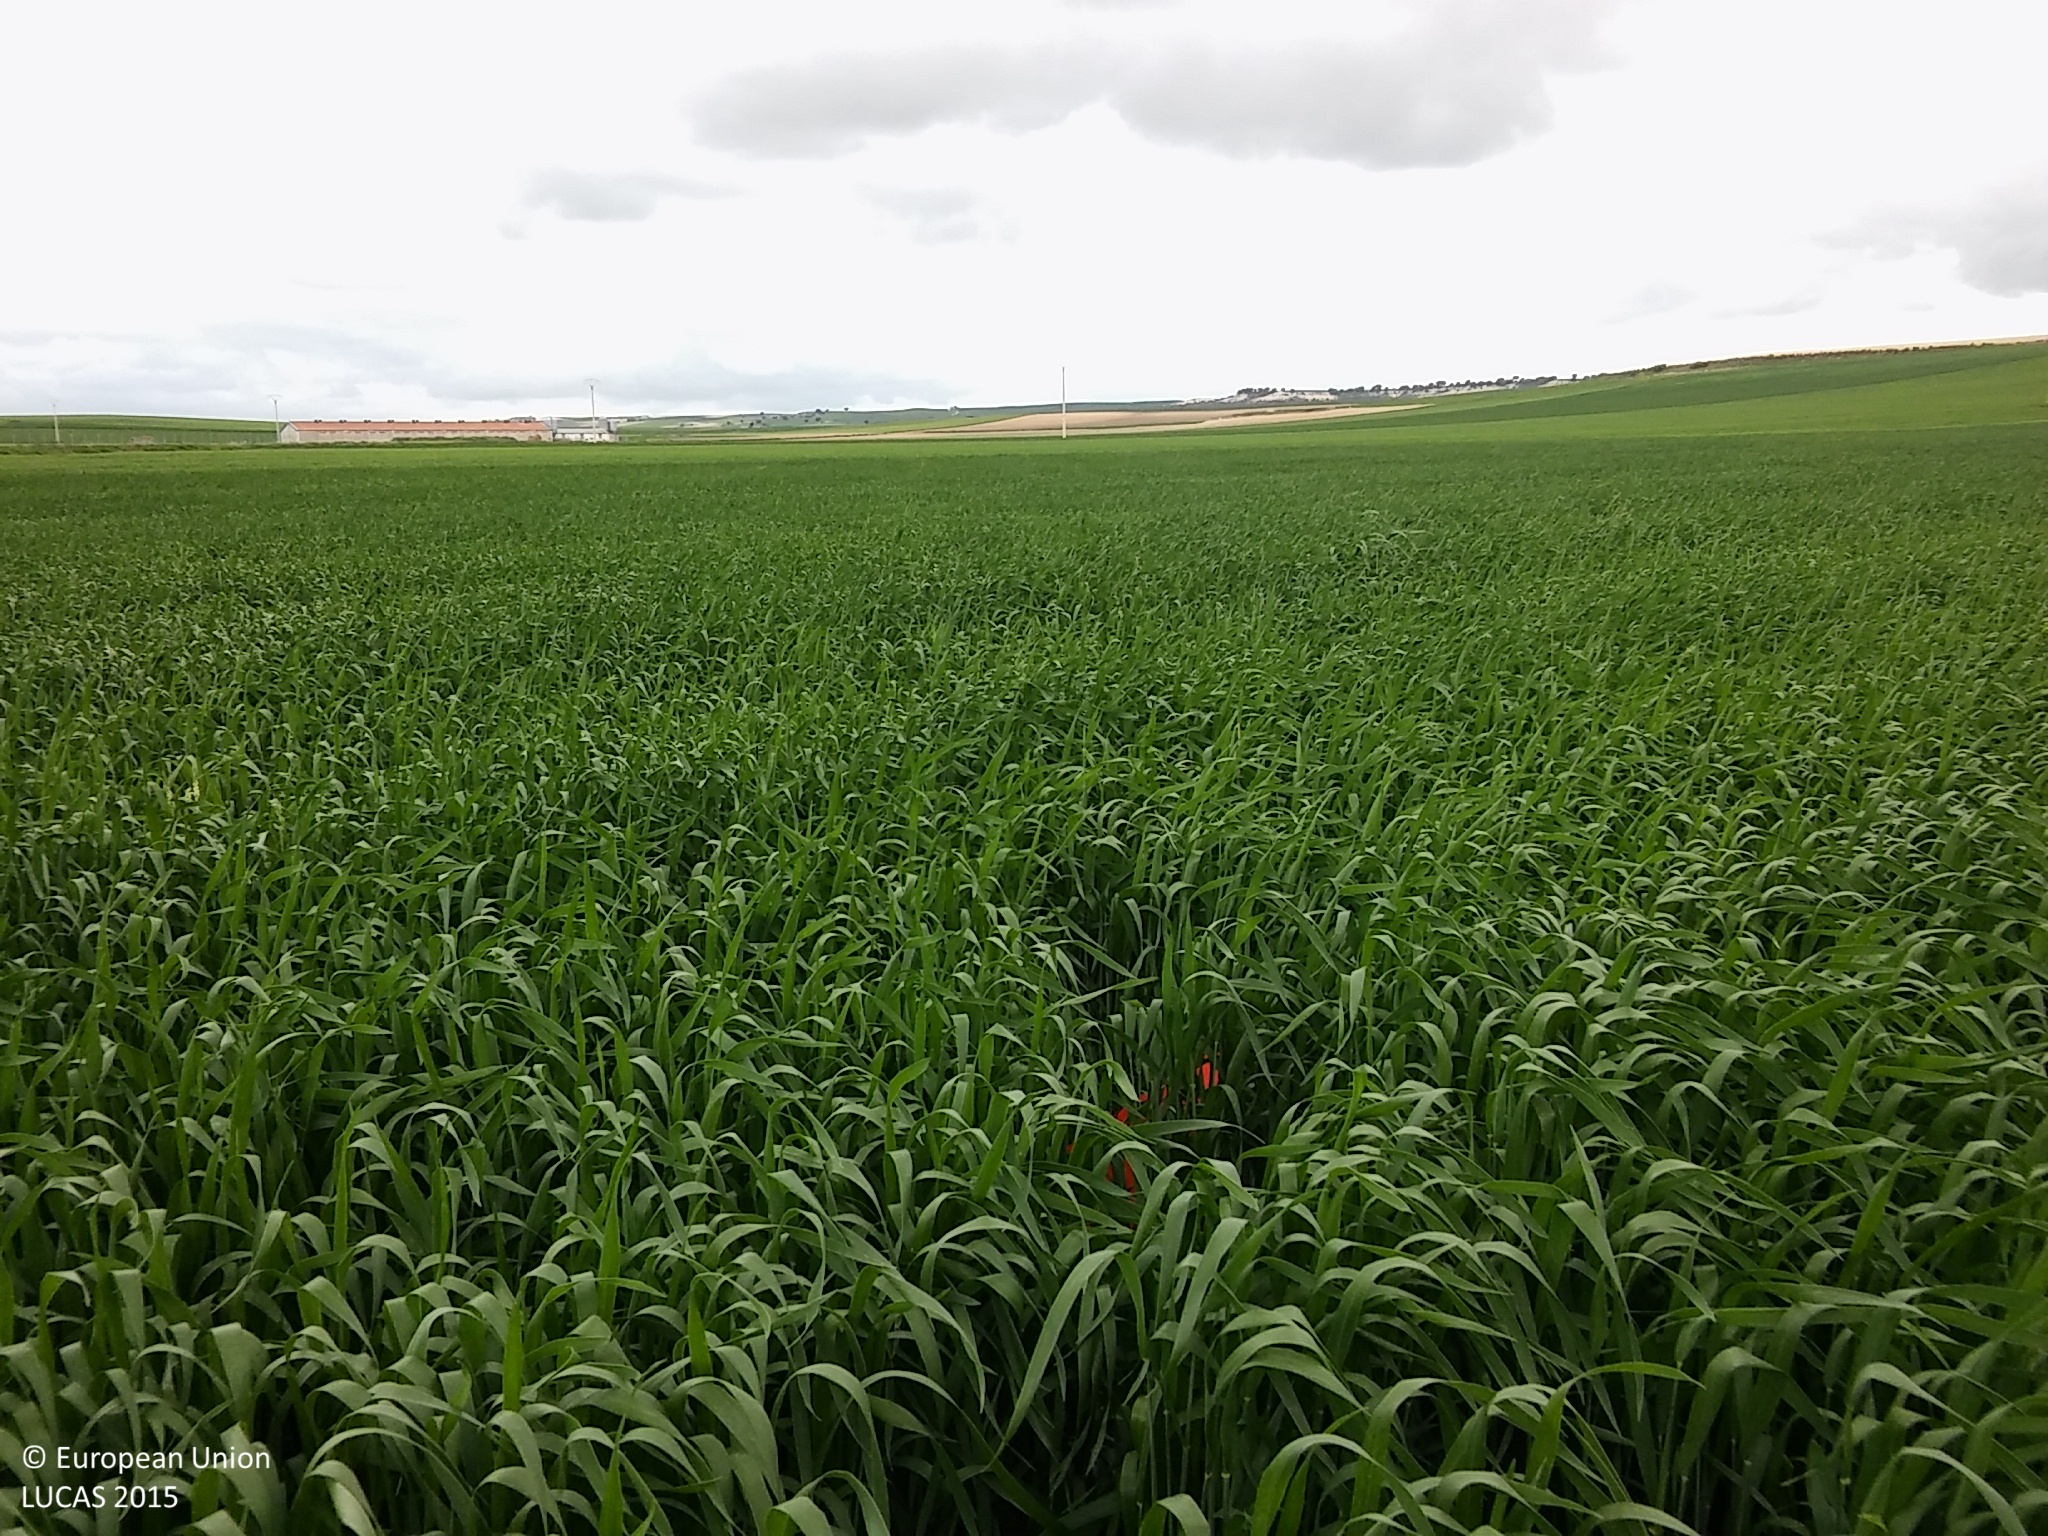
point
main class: Cropland
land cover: Barley
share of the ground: > 75 %
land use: Agriculture (excluding fallow land and kitchen gardens)
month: May
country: ES
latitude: 41.3888
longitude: -3.9618
